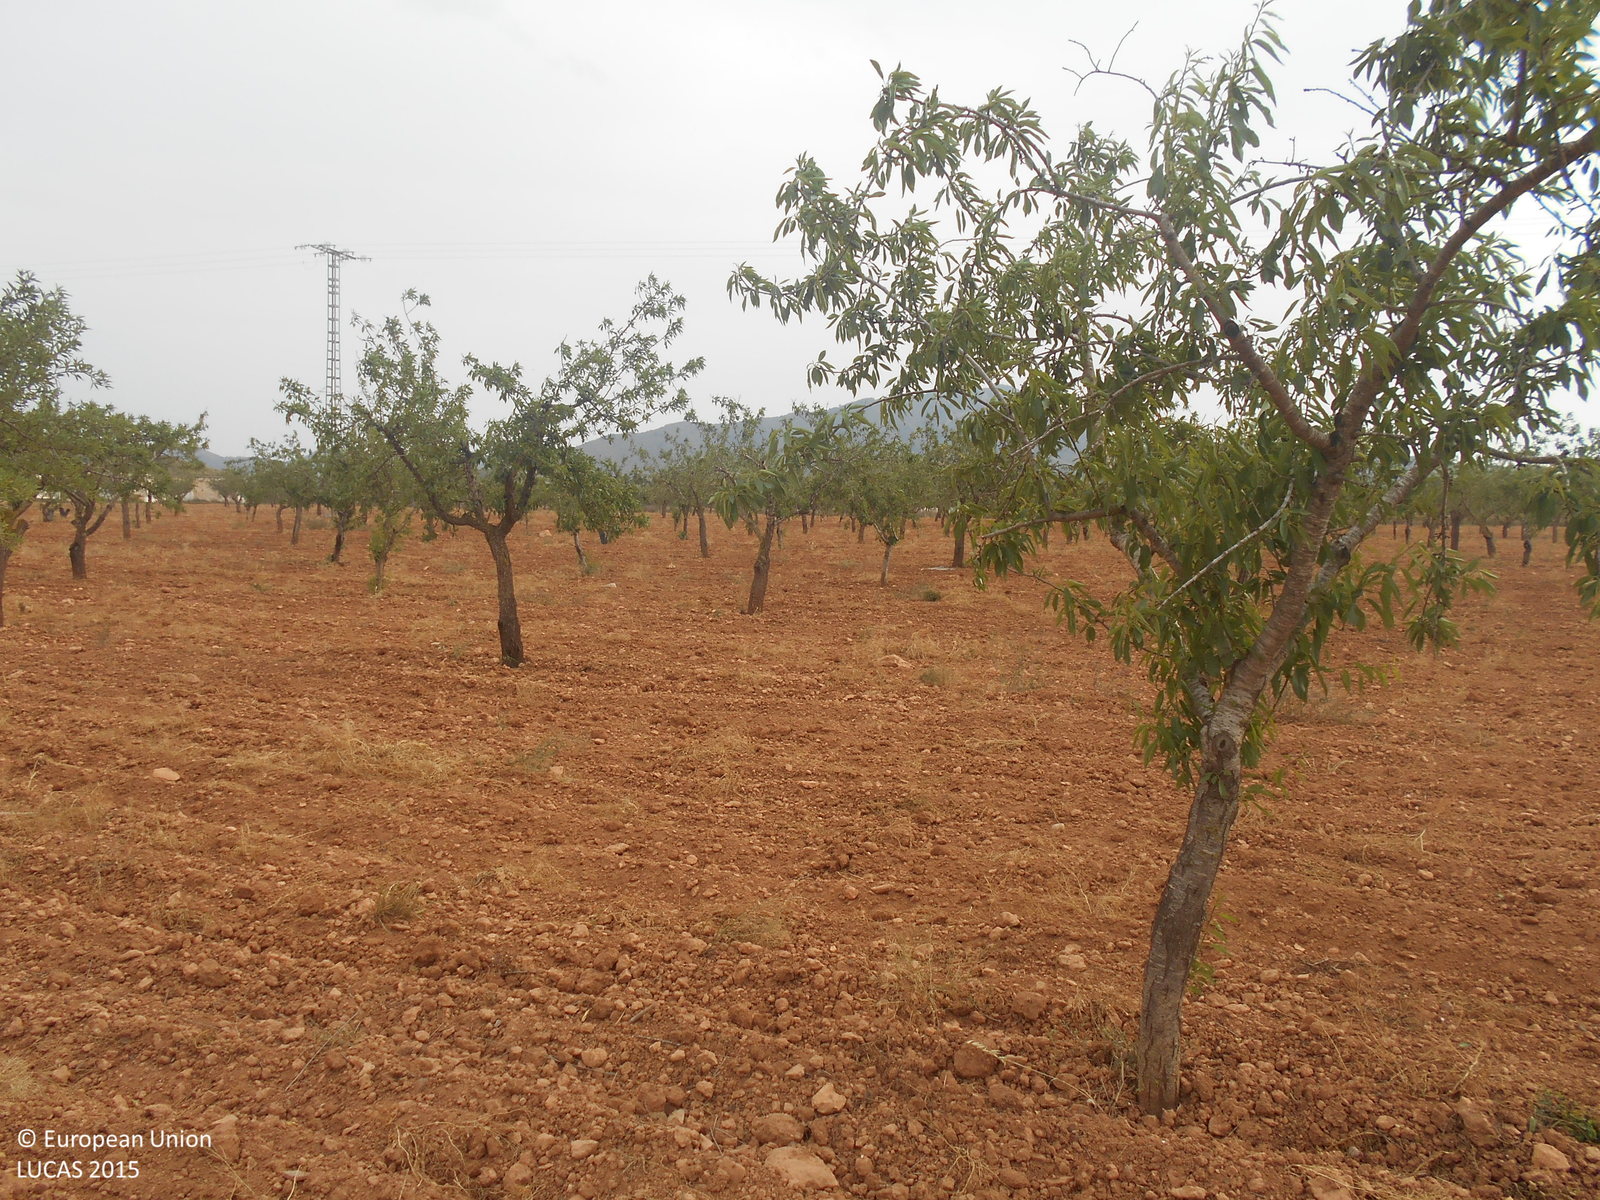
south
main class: Cropland
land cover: Nuts trees
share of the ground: 10 - 25 %
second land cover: Other bare soil
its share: > 75 %
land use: Agriculture (excluding fallow land and kitchen gardens)
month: April
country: ES
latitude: 37.6799
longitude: -1.2627
